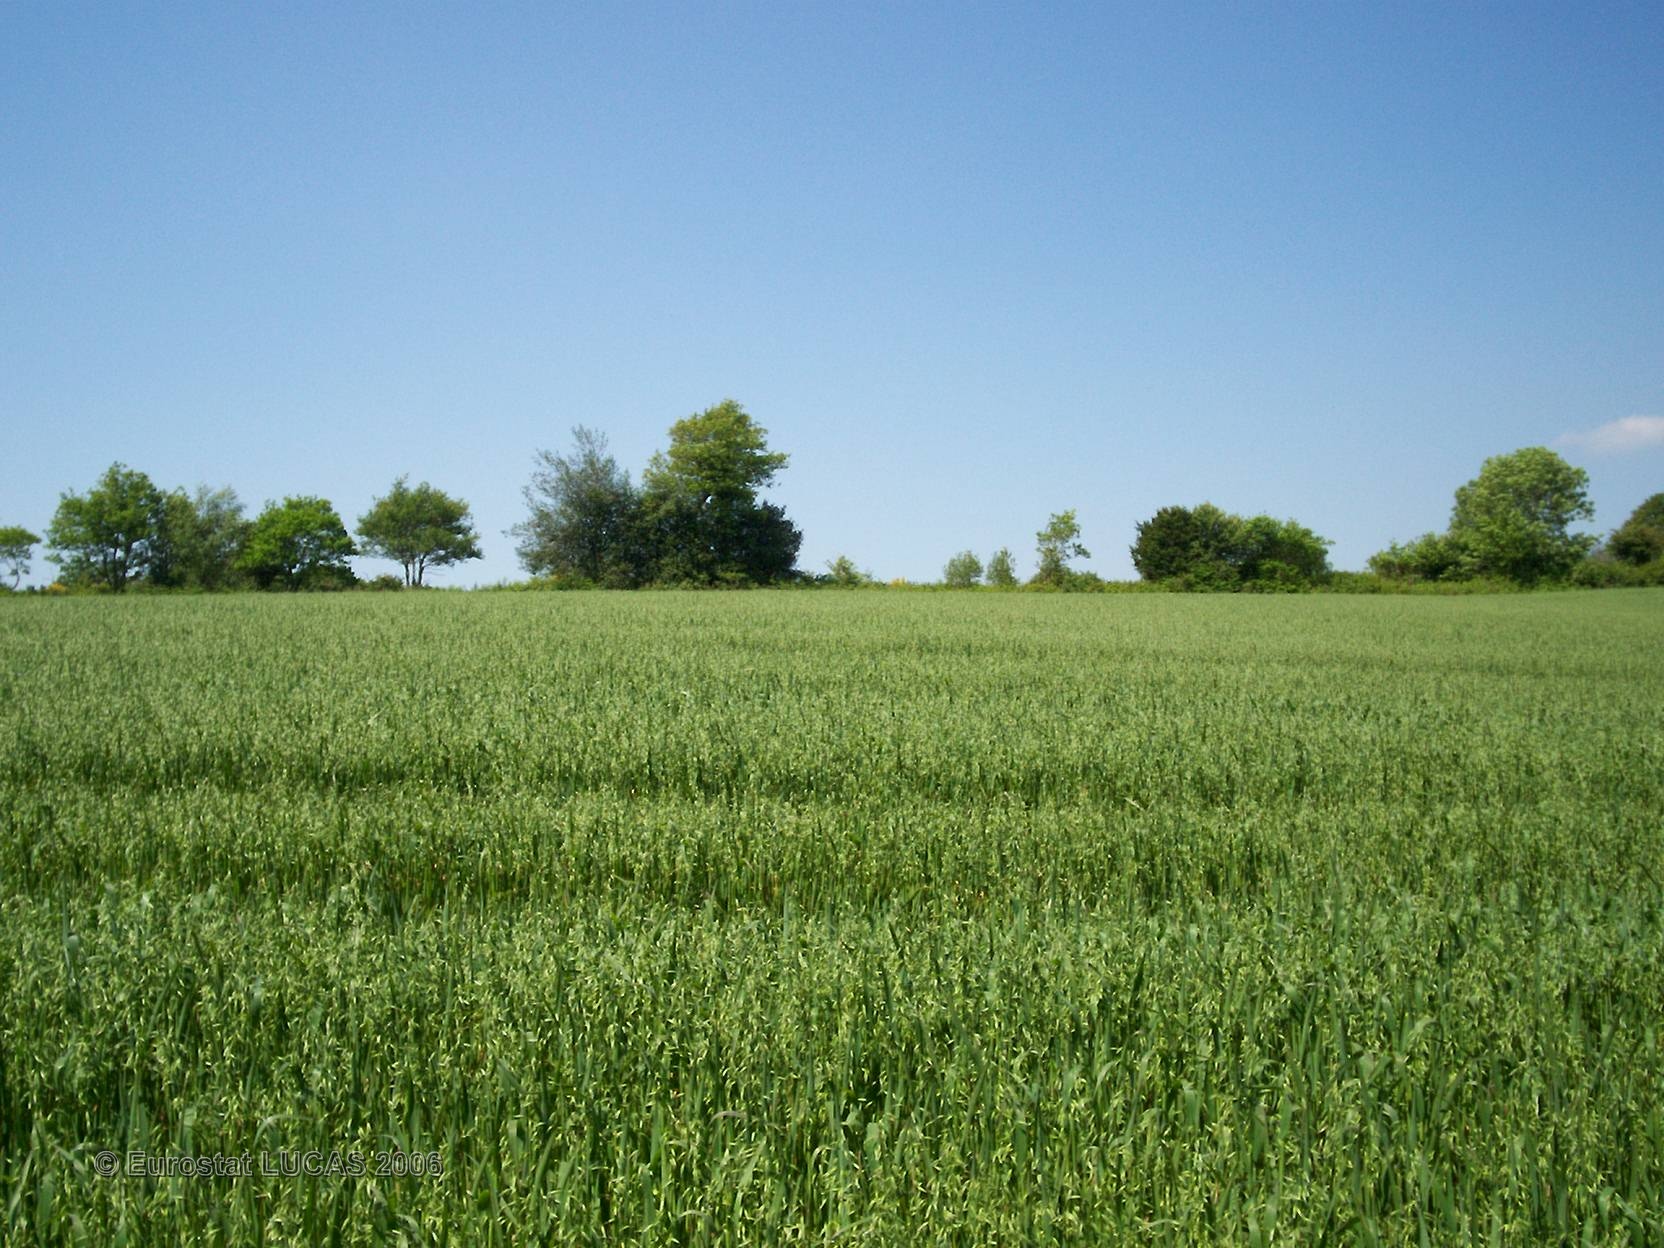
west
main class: Cropland
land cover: Oats
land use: Agriculture (excluding fallow land and kitchen gardens)
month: June
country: FR
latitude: 48.2944
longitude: -3.9846
